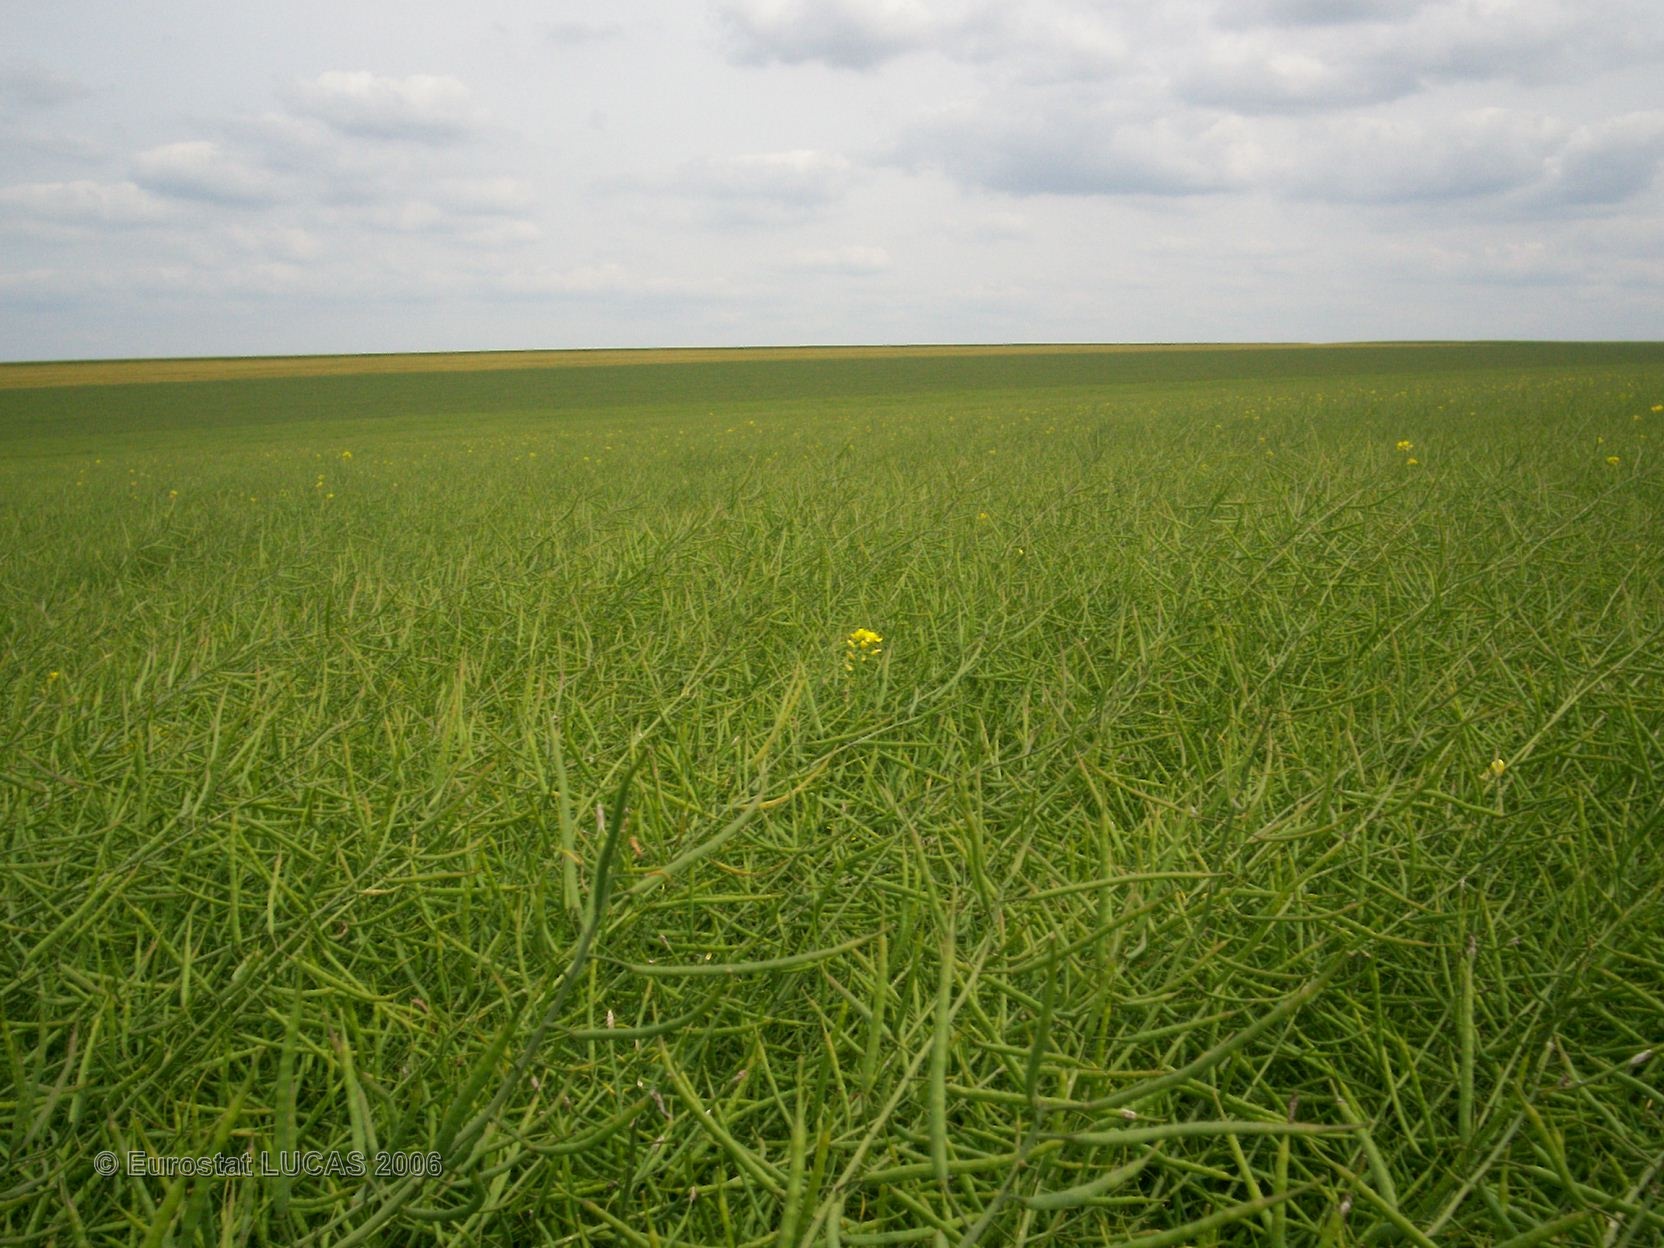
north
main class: Cropland
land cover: Rape and turnip rape
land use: Agriculture (excluding fallow land and kitchen gardens)
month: June
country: FR
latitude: 48.8851
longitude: 4.6103
